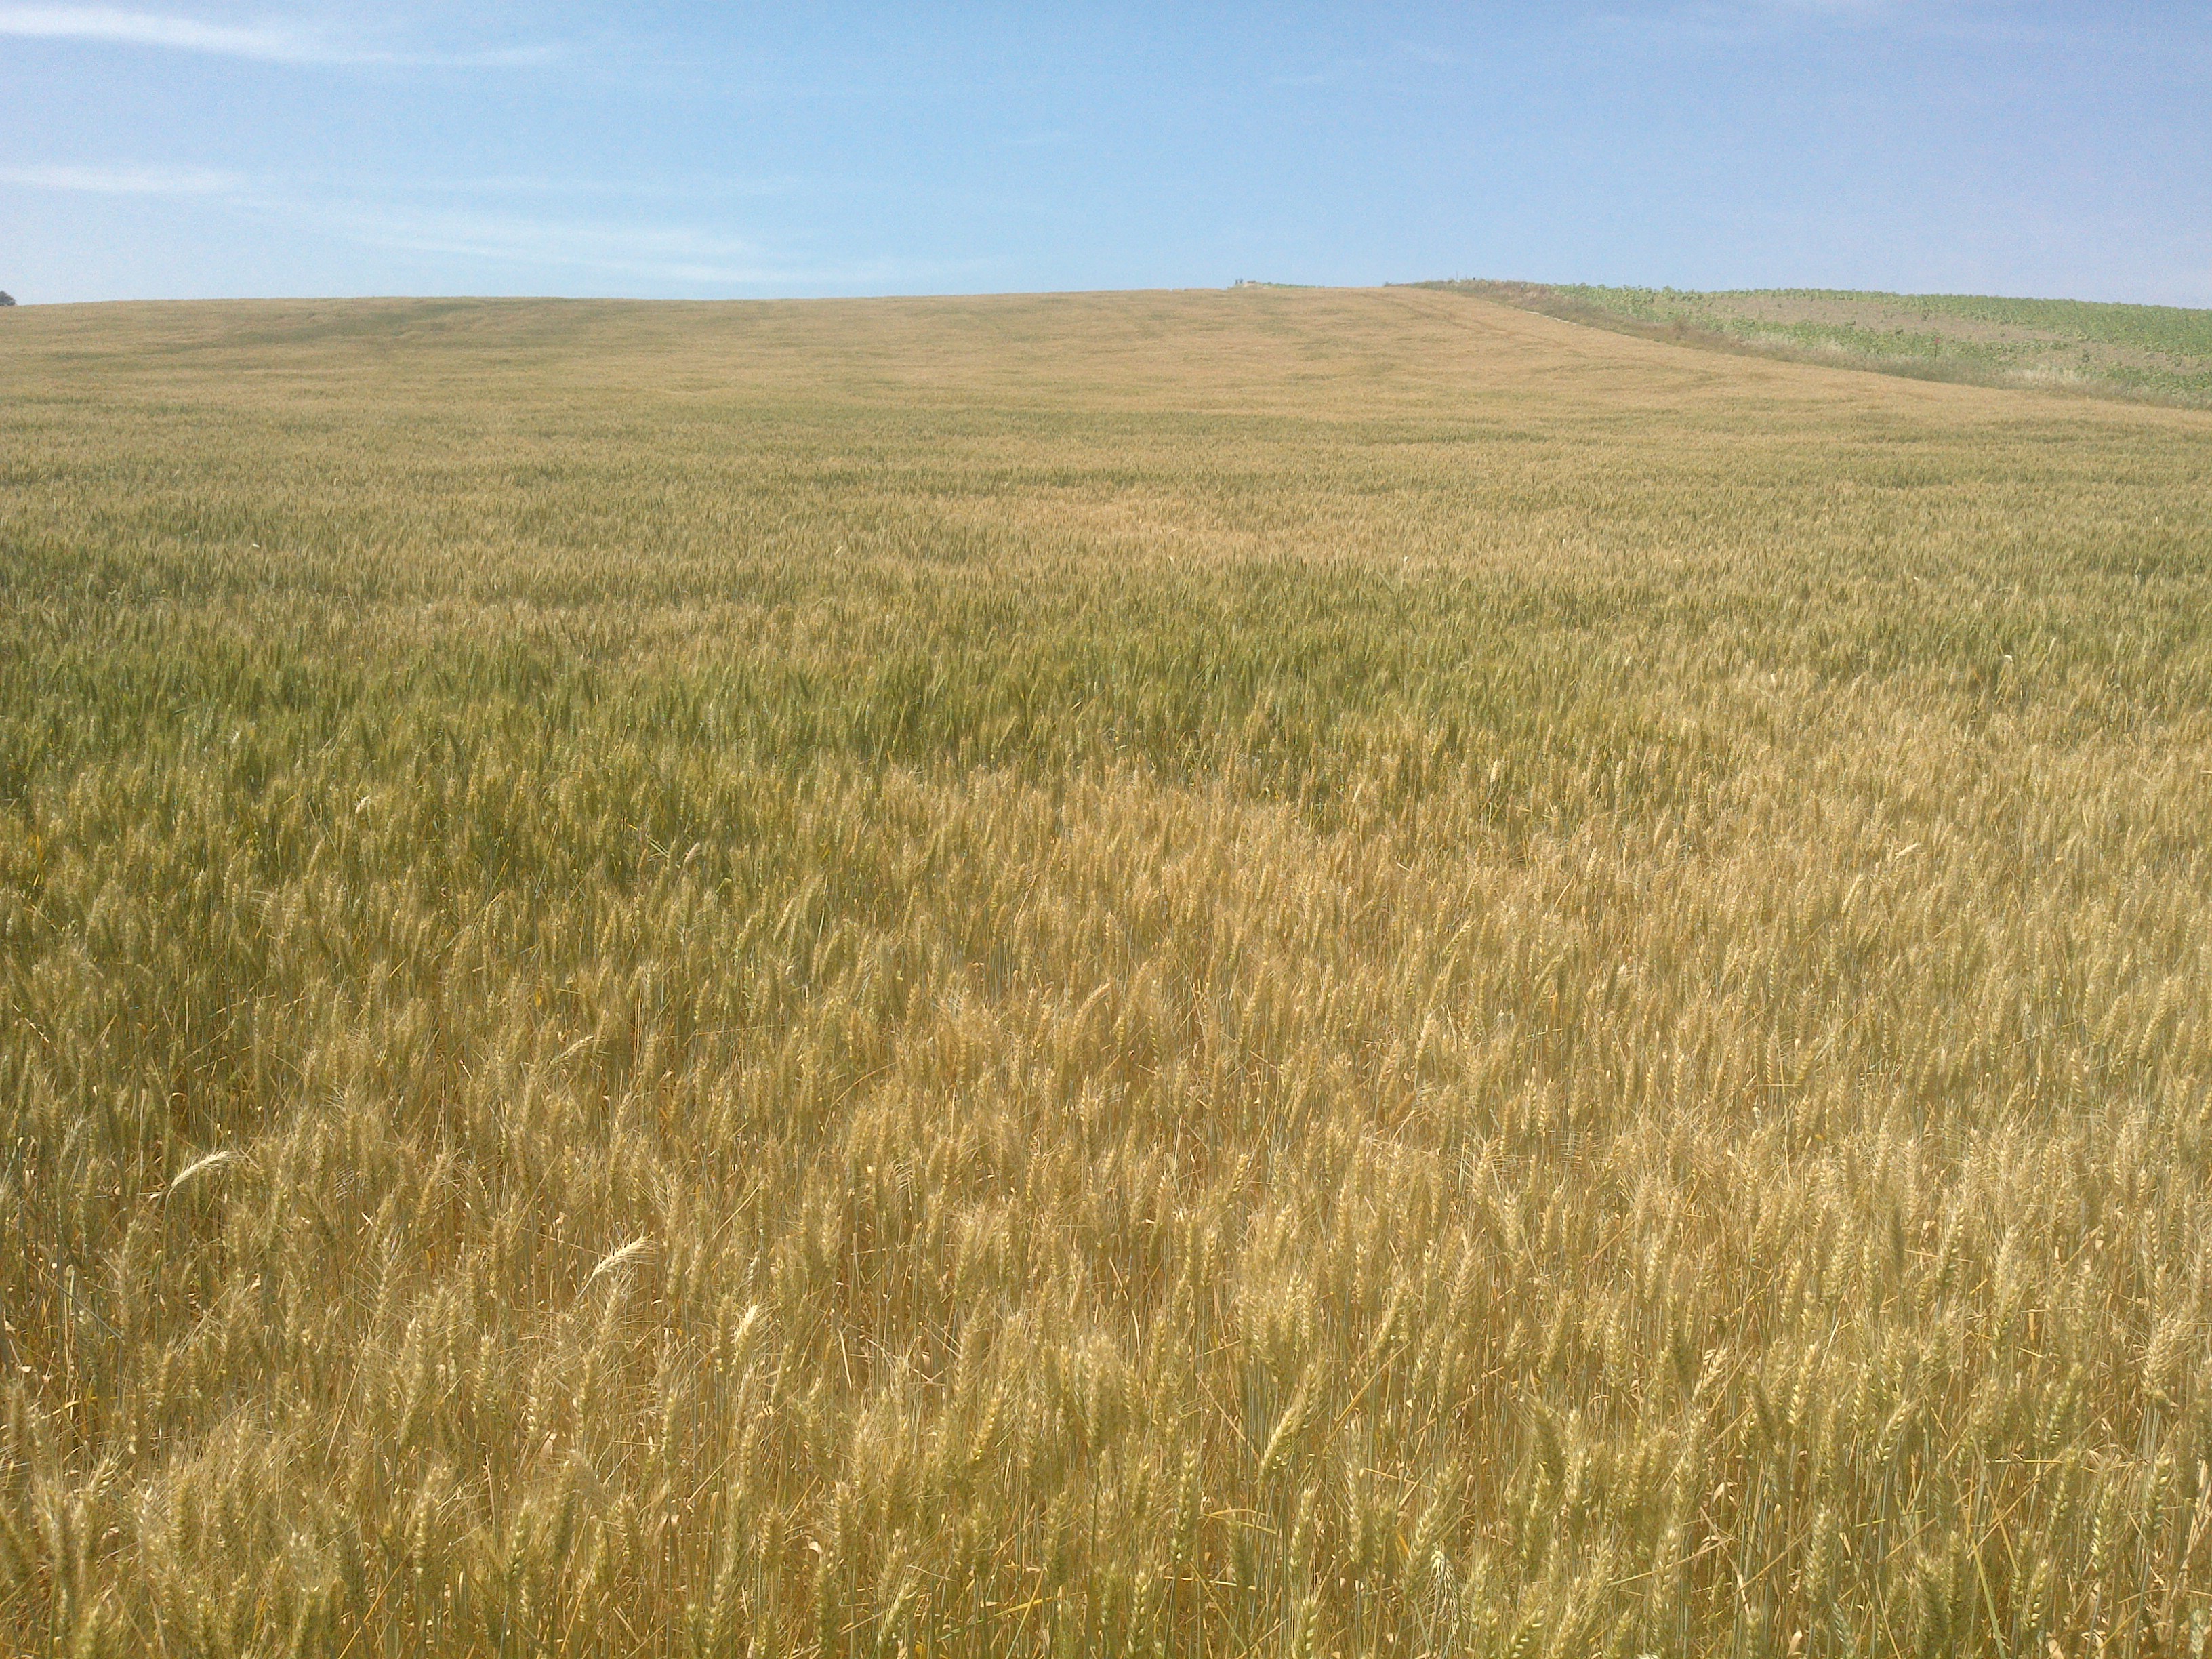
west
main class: Cropland
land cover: Durum wheat
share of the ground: > 75 %
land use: Agriculture (excluding fallow land and kitchen gardens)
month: May
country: ES
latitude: 37.8405
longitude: -4.6364
